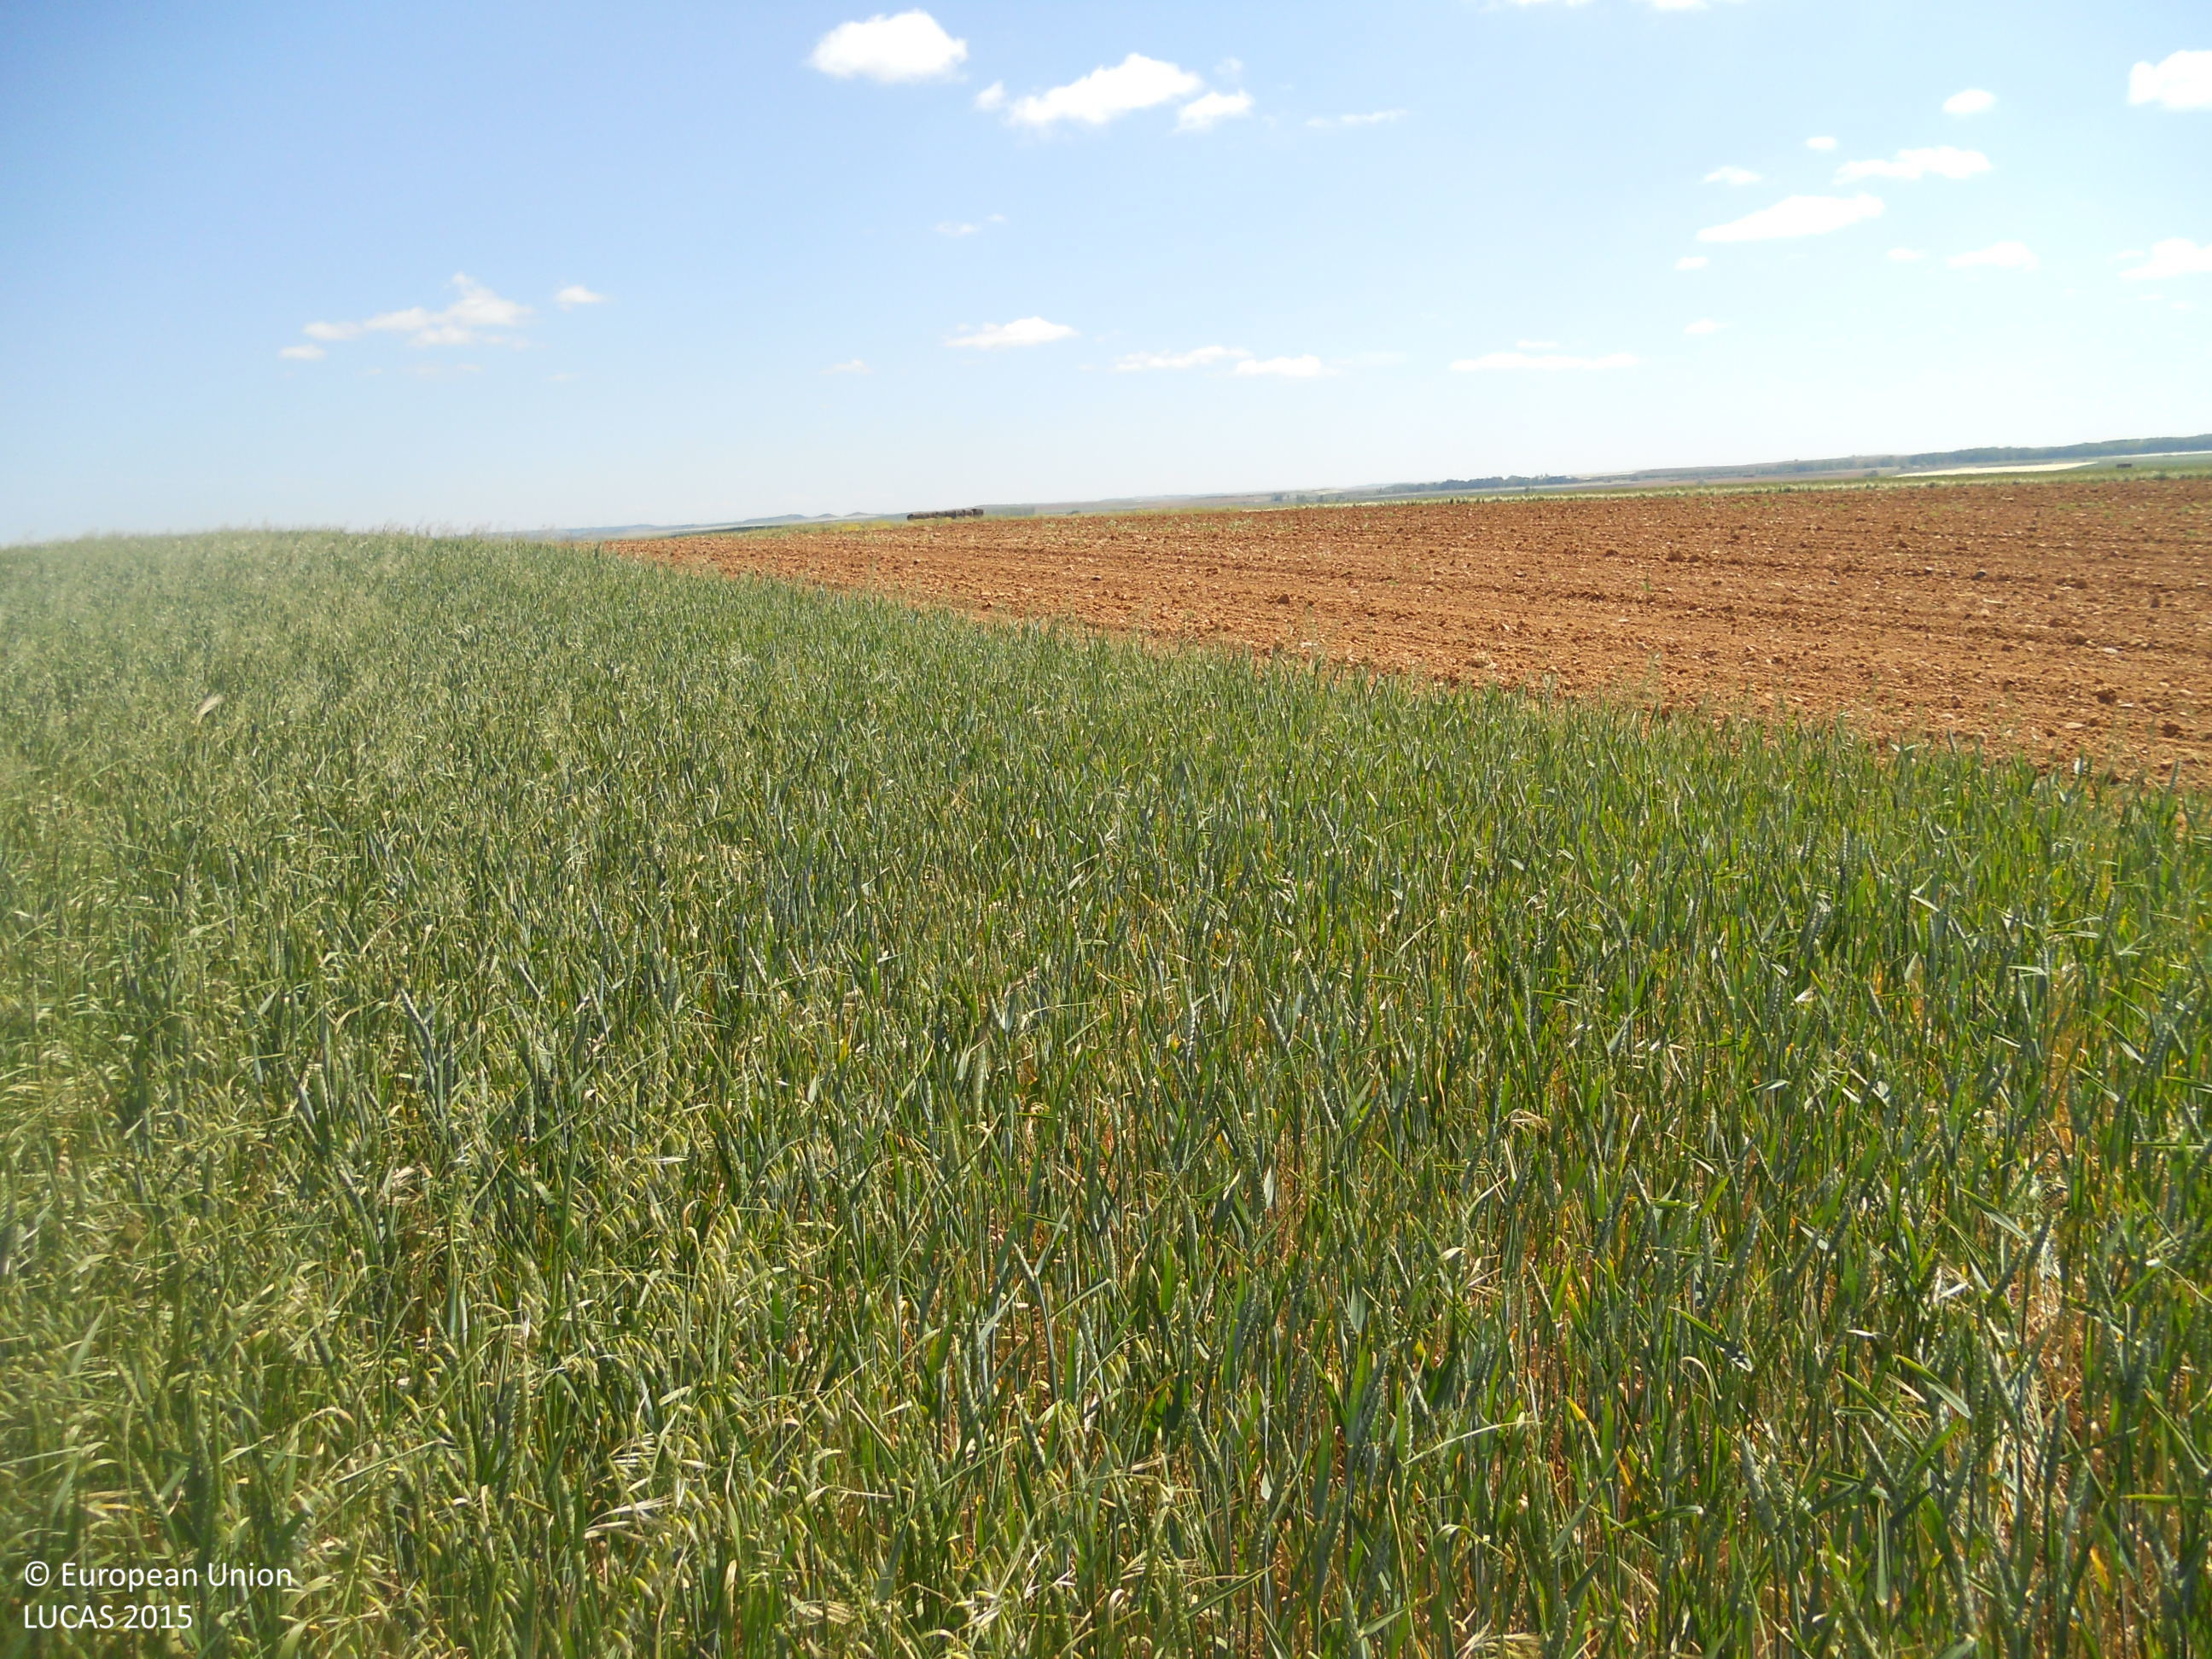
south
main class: Cropland
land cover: Common wheat
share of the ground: > 75 %
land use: Agriculture (excluding fallow land and kitchen gardens)
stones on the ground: < 10 %
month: May
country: ES
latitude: 42.3639
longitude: -4.3134
